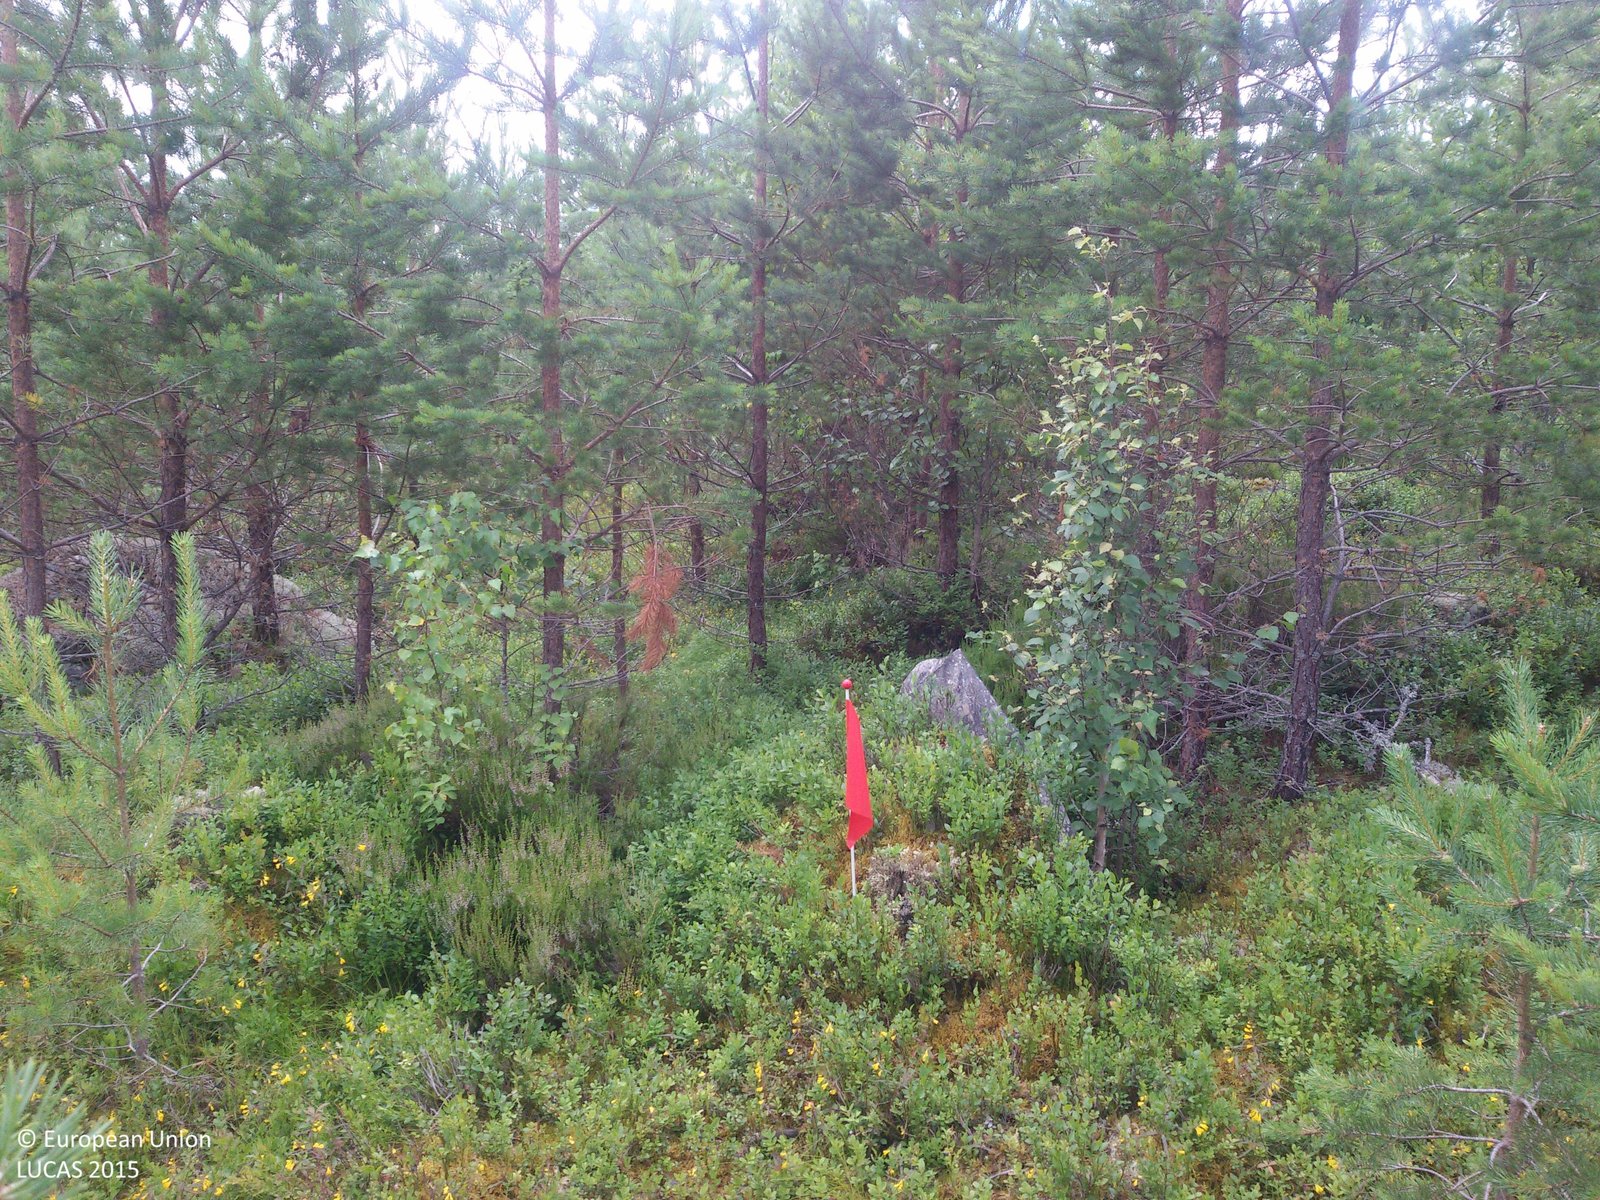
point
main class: Woodland
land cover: Pine dominated mixed woodland
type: boreal forest
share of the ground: > 75 %
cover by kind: coniferous forest trees 50 %, broadleaved forest trees 30 %, shrubs 15 %, lichens and mosses 5 %
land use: Forestry
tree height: < 5 m
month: July
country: SE
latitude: 60.5279
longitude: 15.8732
